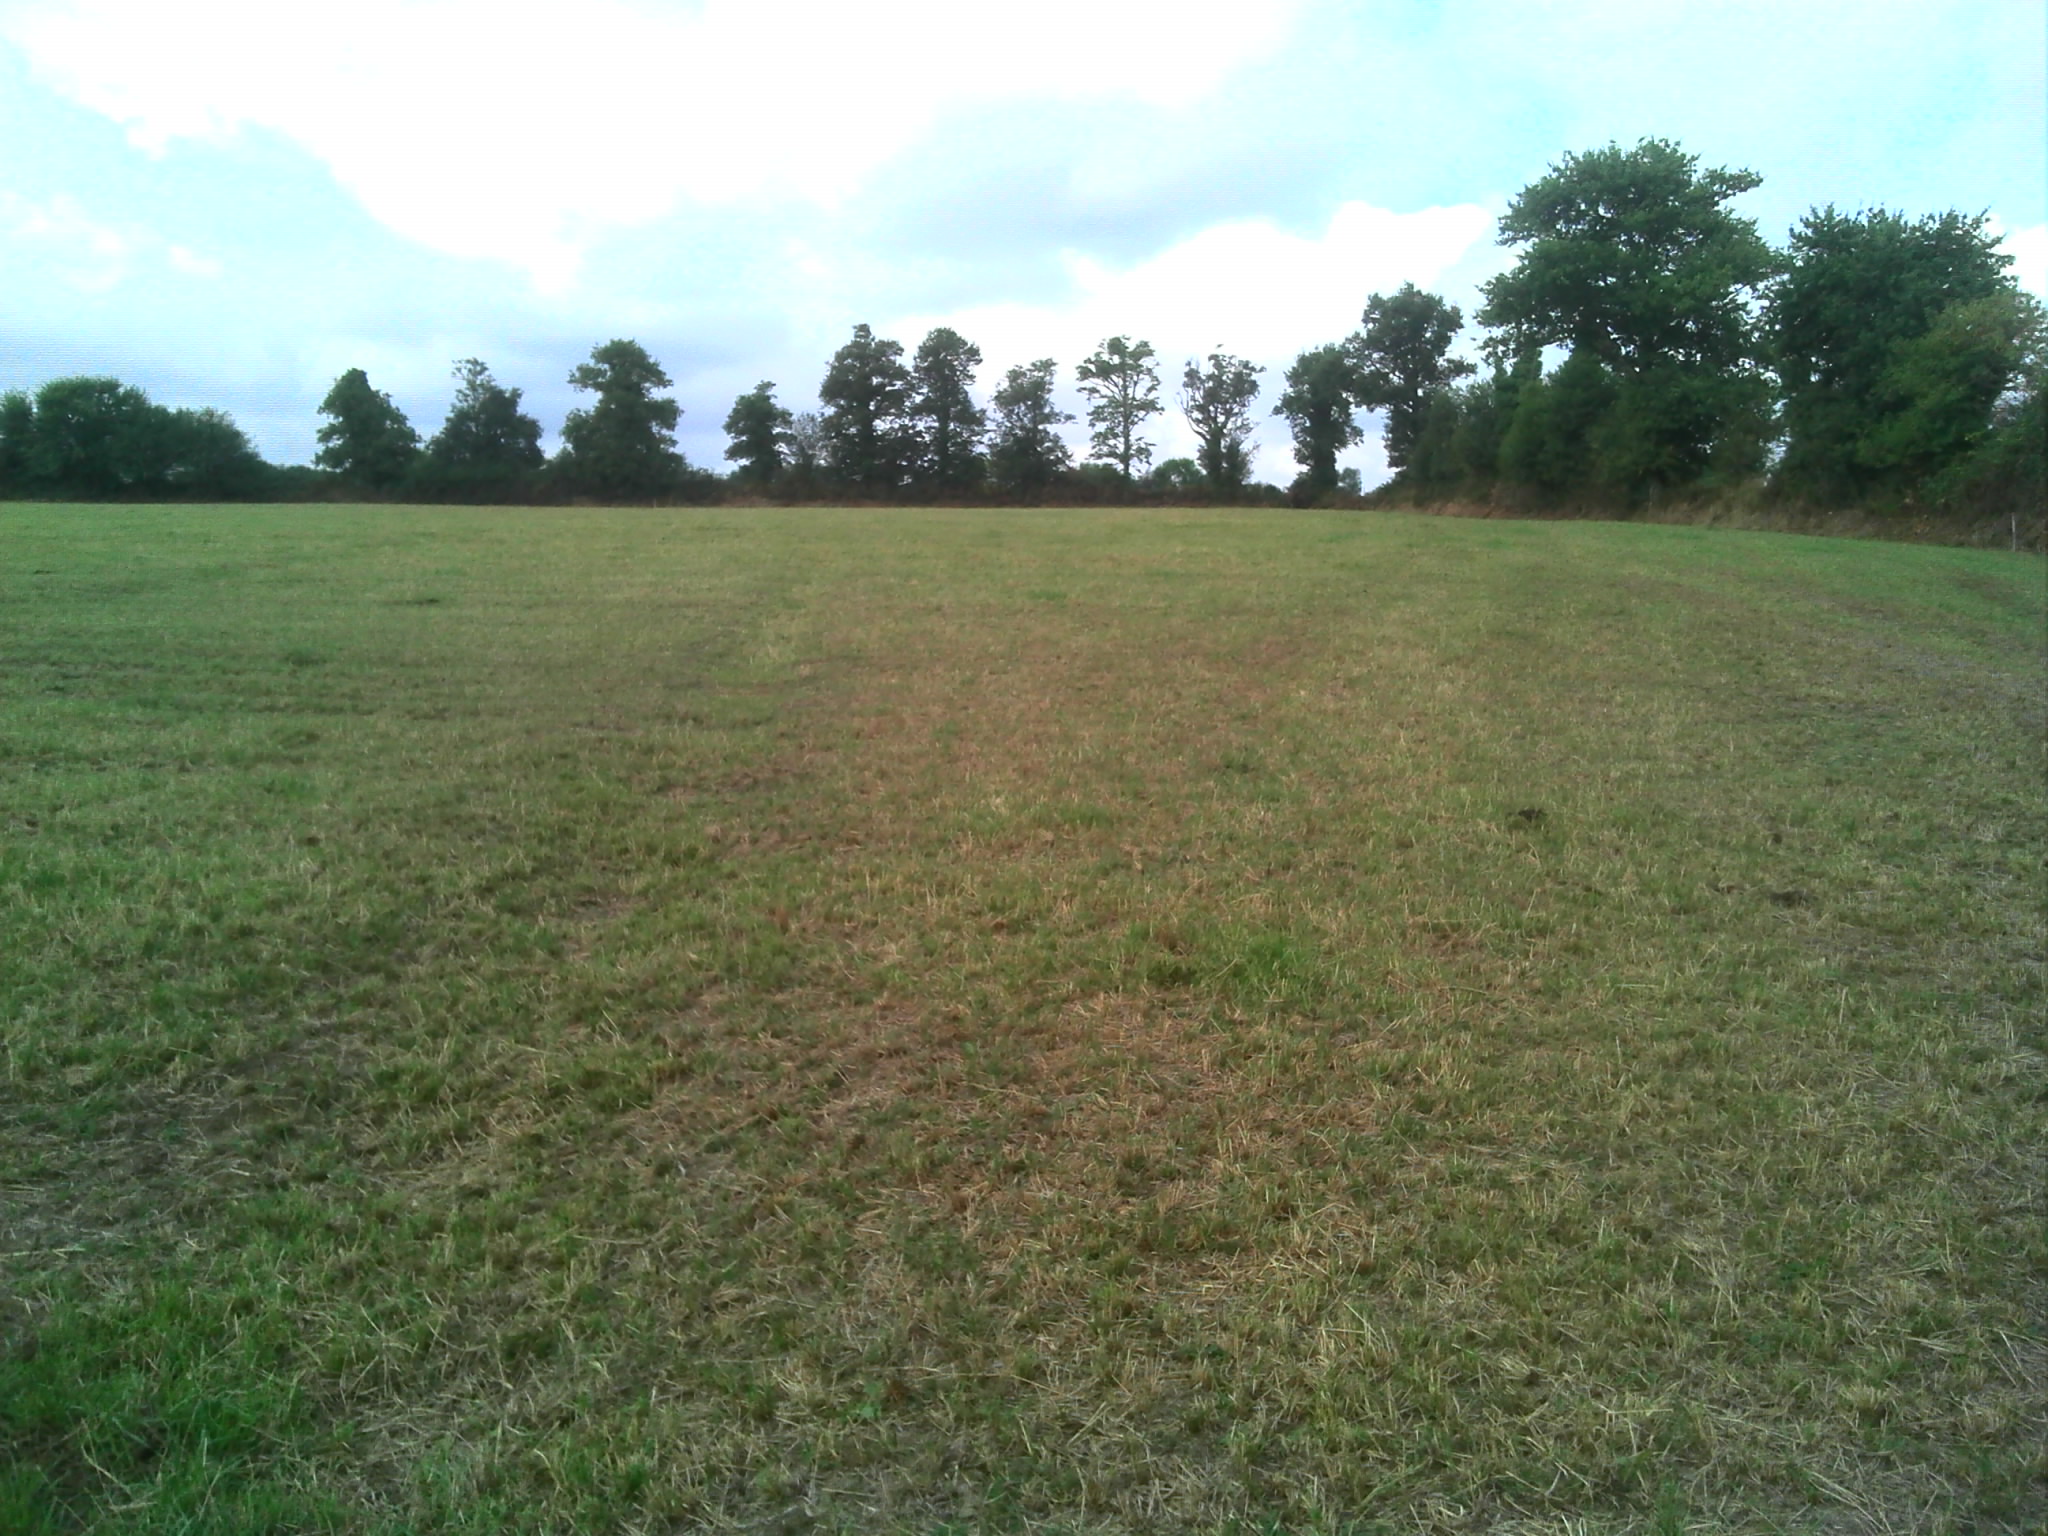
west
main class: Grassland
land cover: Grassland without tree/shrub cover
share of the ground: > 75 %
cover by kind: herbaceous plants 100 %
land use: Agriculture (excluding fallow land and kitchen gardens)
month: August
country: FR
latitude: 46.6273
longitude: -1.5984
